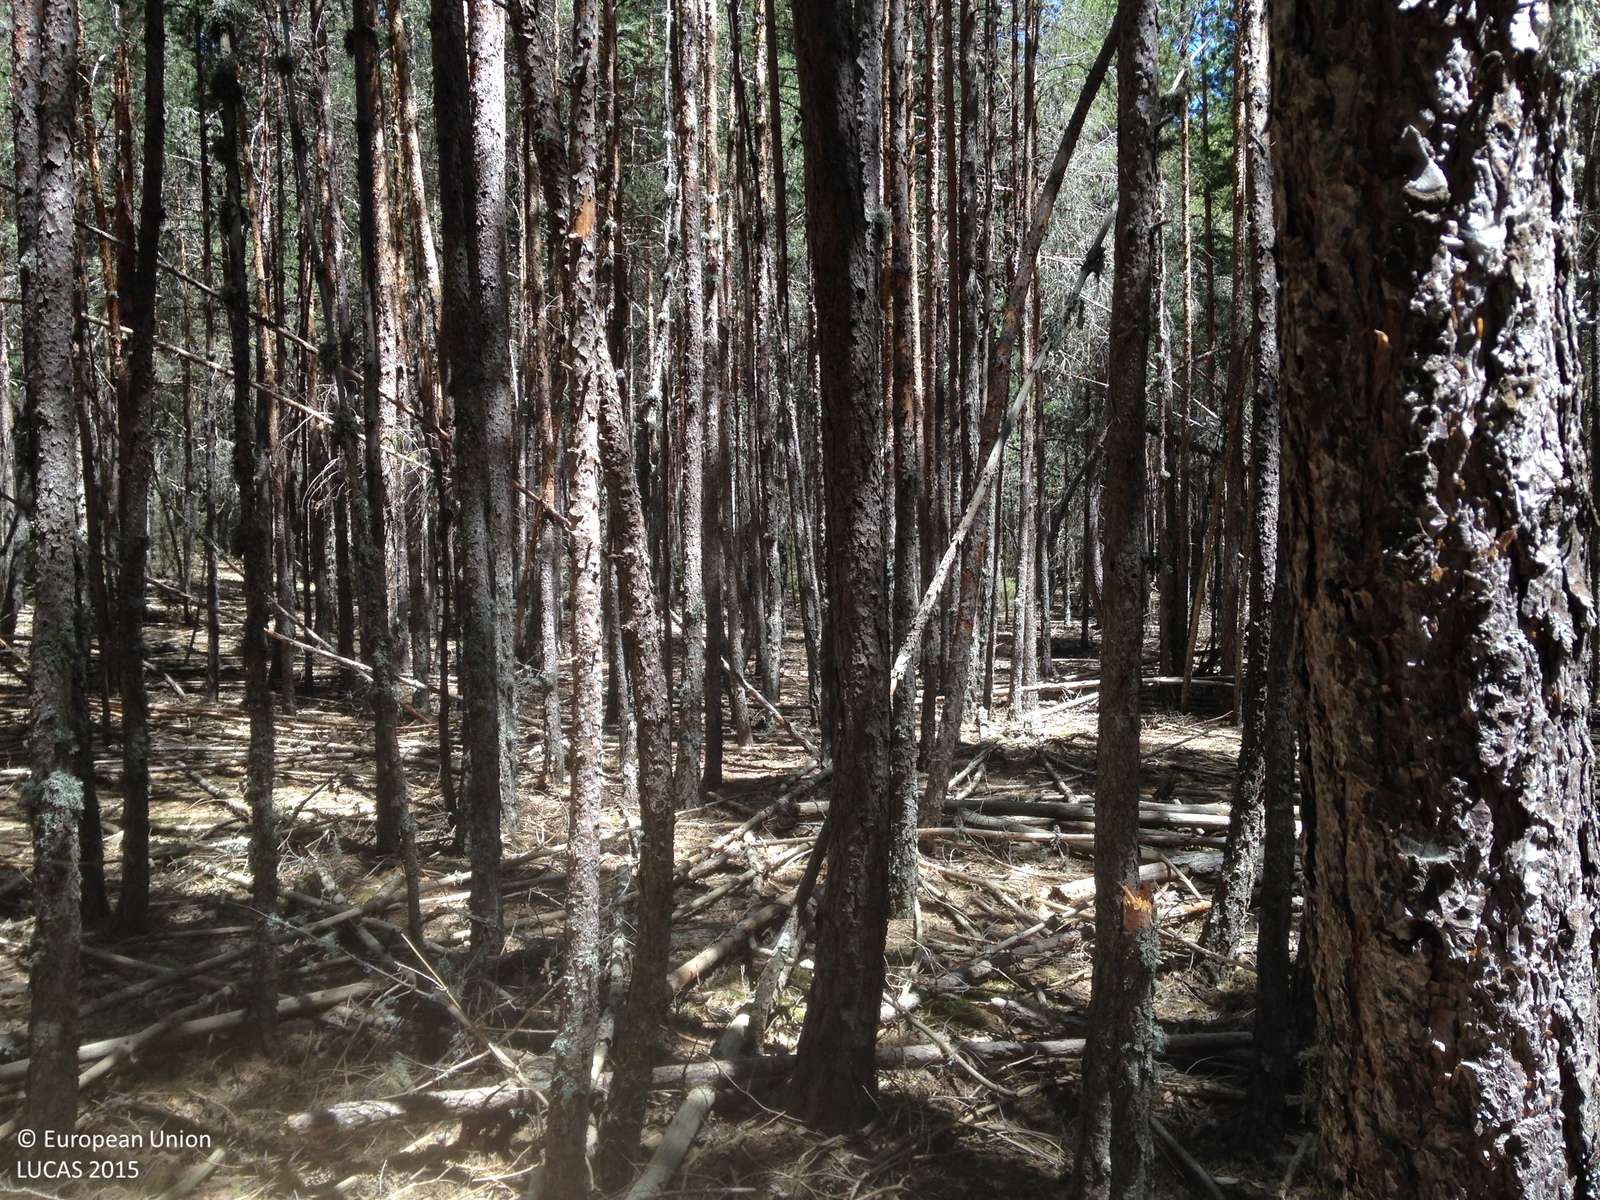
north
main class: Woodland
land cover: Pine dominated coniferous woodland
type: coniferous forest of the mediterranean region
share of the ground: > 75 %
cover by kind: coniferous forest trees 90 %
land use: Forestry
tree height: > 5 m
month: May
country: ES
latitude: 40.5530
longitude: -1.9825
